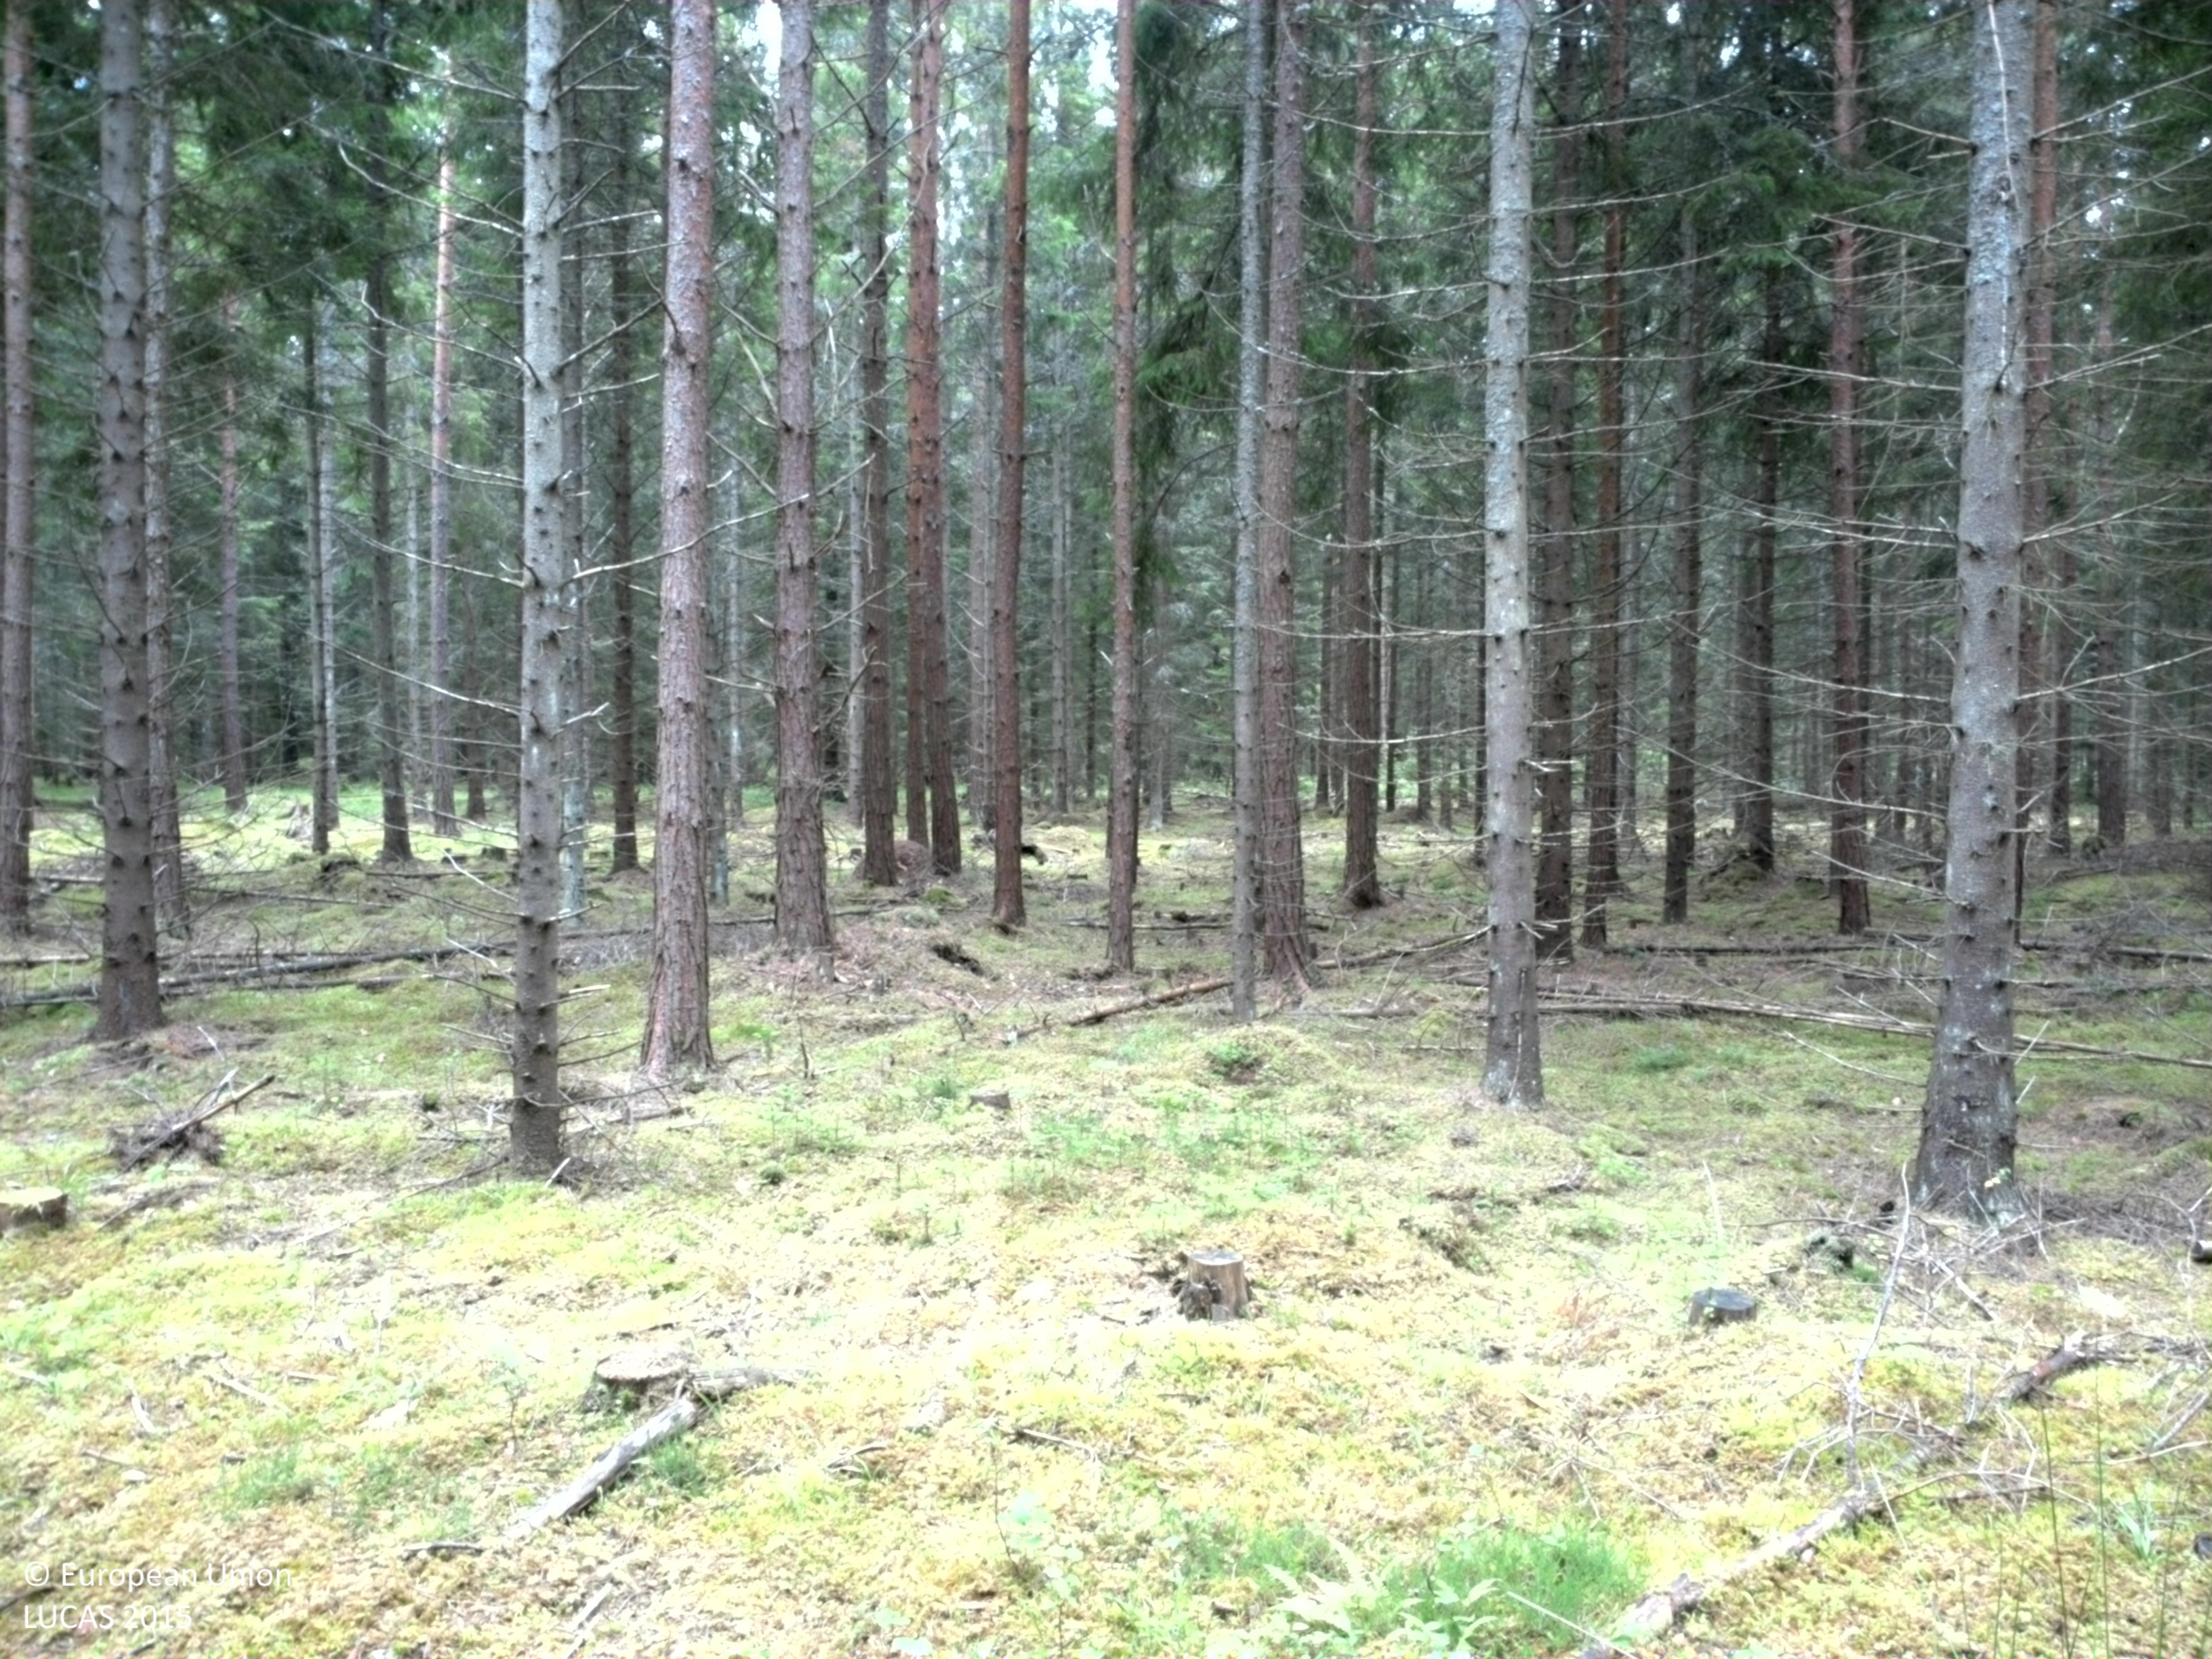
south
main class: Woodland
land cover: Spruce dominated coniferous woodland
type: boreal forest
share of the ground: 50 - 75 %
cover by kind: coniferous forest trees 75 %, lichens and mosses 25 %
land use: Forestry
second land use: Amenities, museums, leisure
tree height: > 5 m
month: July
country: SE
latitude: 58.6270
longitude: 13.3864
